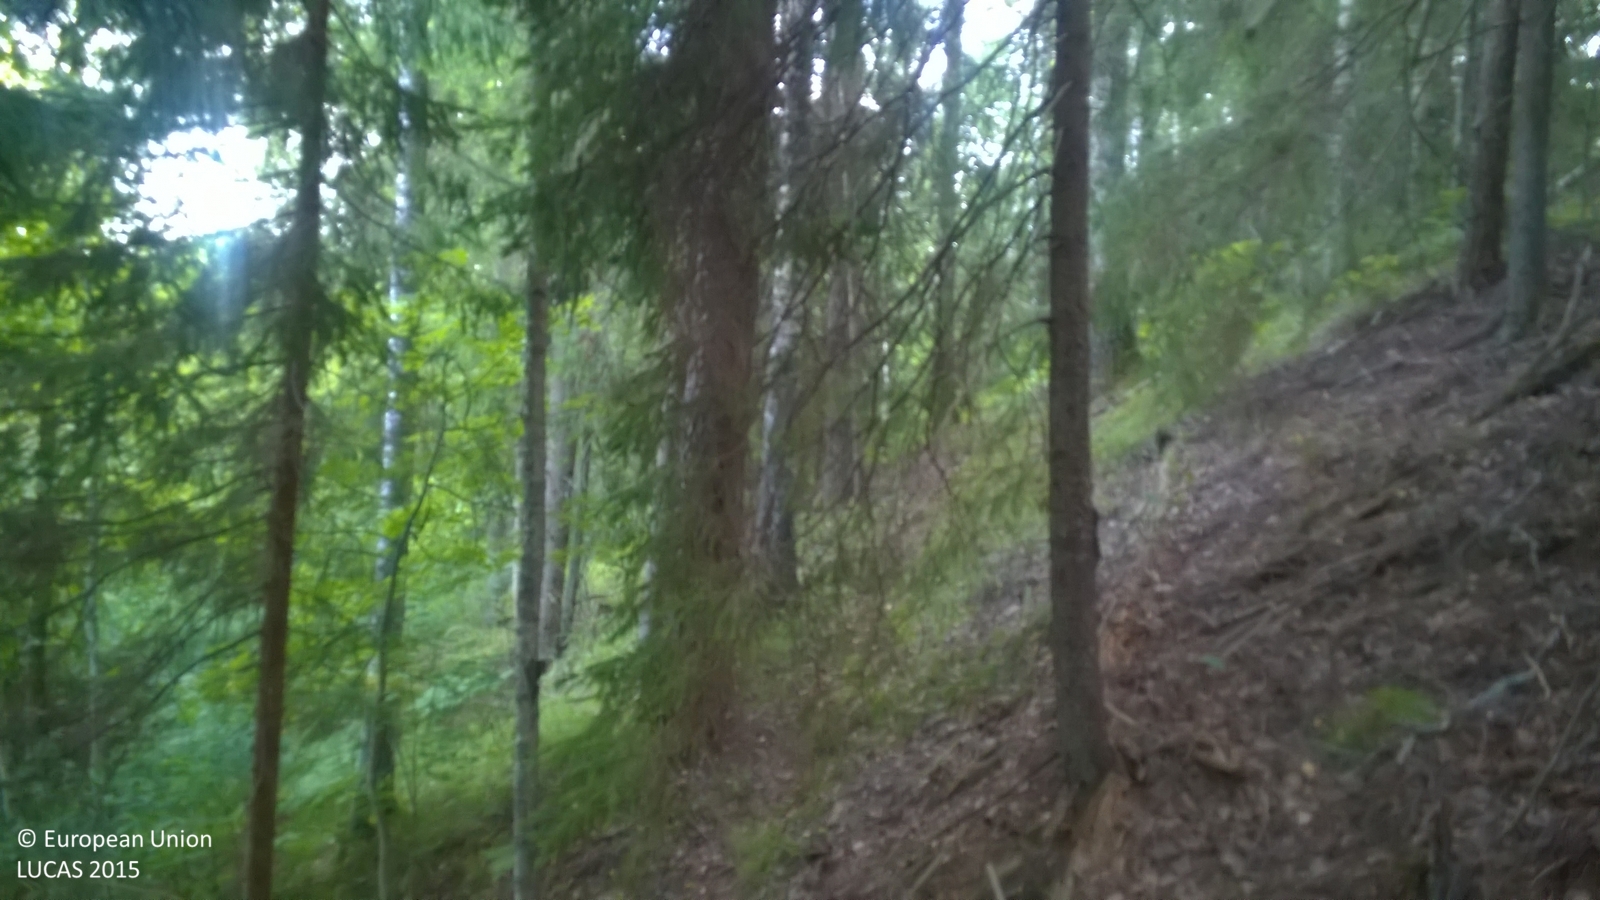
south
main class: Woodland
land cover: Other mixed woodland
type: hemiboreal forest and nemoral coniferous forest and mixed broadleaved-coniferous forest
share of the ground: > 75 %
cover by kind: coniferous forest trees 50 %, broadleaved forest trees 35 %, herbaceous plants 5 %, lichens and mosses 5 %, unconsolidated bare surface 5 %
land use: Forestry
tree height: > 5 m
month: August
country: LV
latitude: 57.7046
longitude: 26.0541
